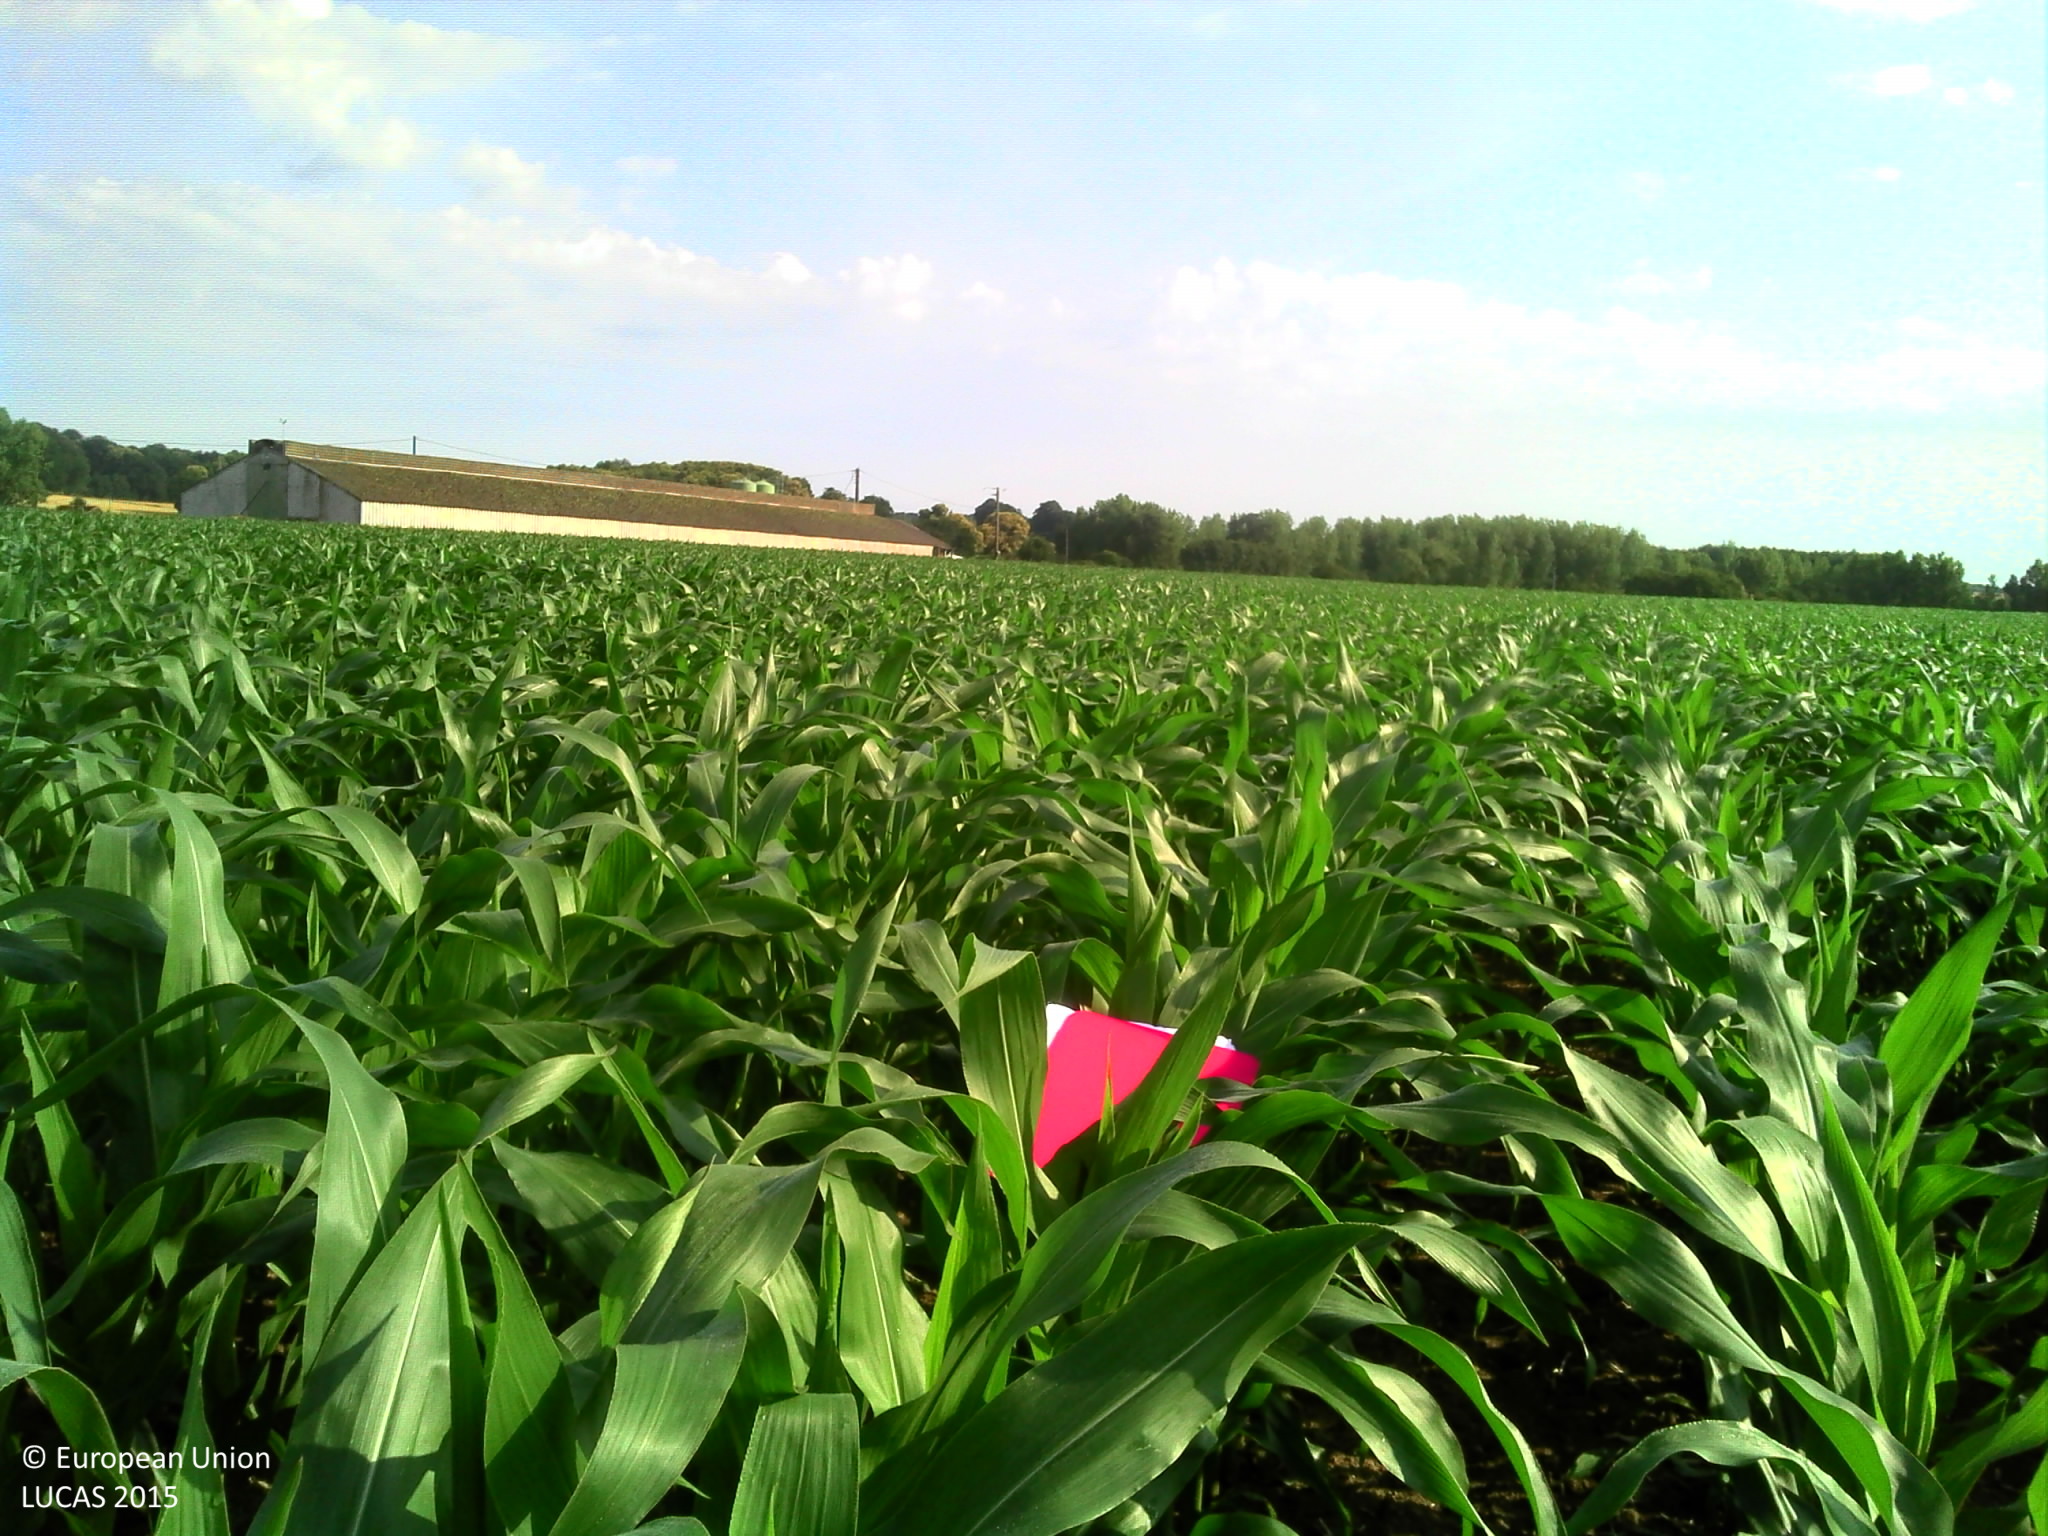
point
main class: Cropland
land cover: Maize
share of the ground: > 75 %
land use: Agriculture (excluding fallow land and kitchen gardens)
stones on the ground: < 10 %
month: July
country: FR
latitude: 48.4144
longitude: -1.5452
